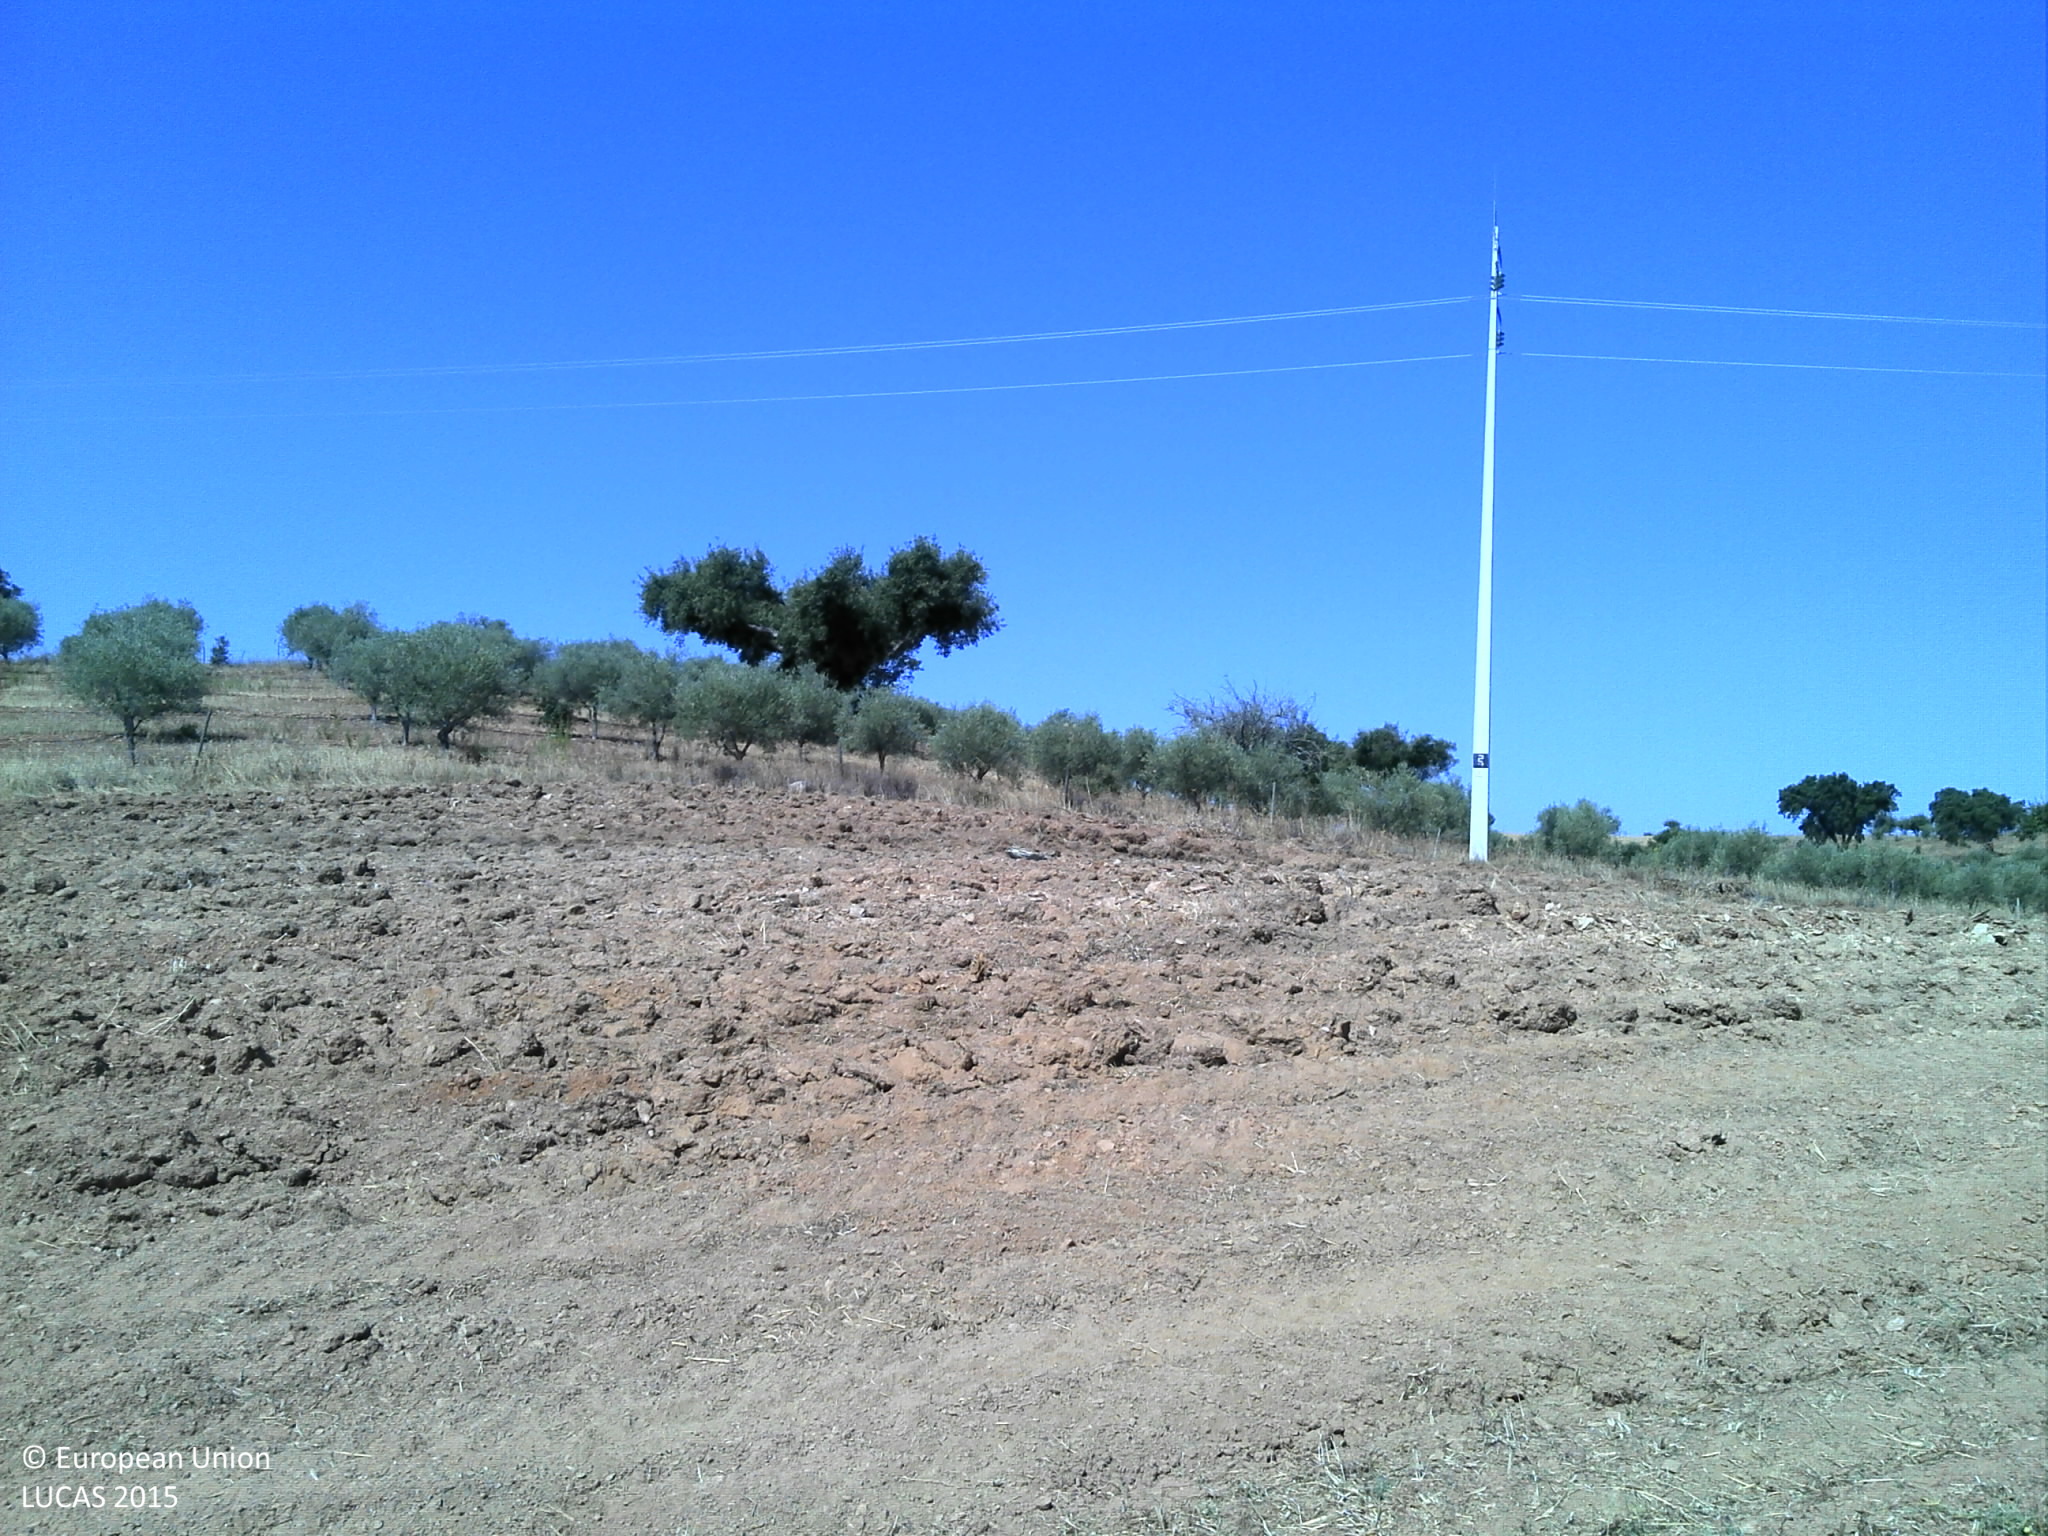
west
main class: Cropland
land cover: Olive groves
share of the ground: 10 - 25 %
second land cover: Oats
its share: < 10 %
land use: Agriculture (excluding fallow land and kitchen gardens)
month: July
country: PT
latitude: 38.5328
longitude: -7.5004
